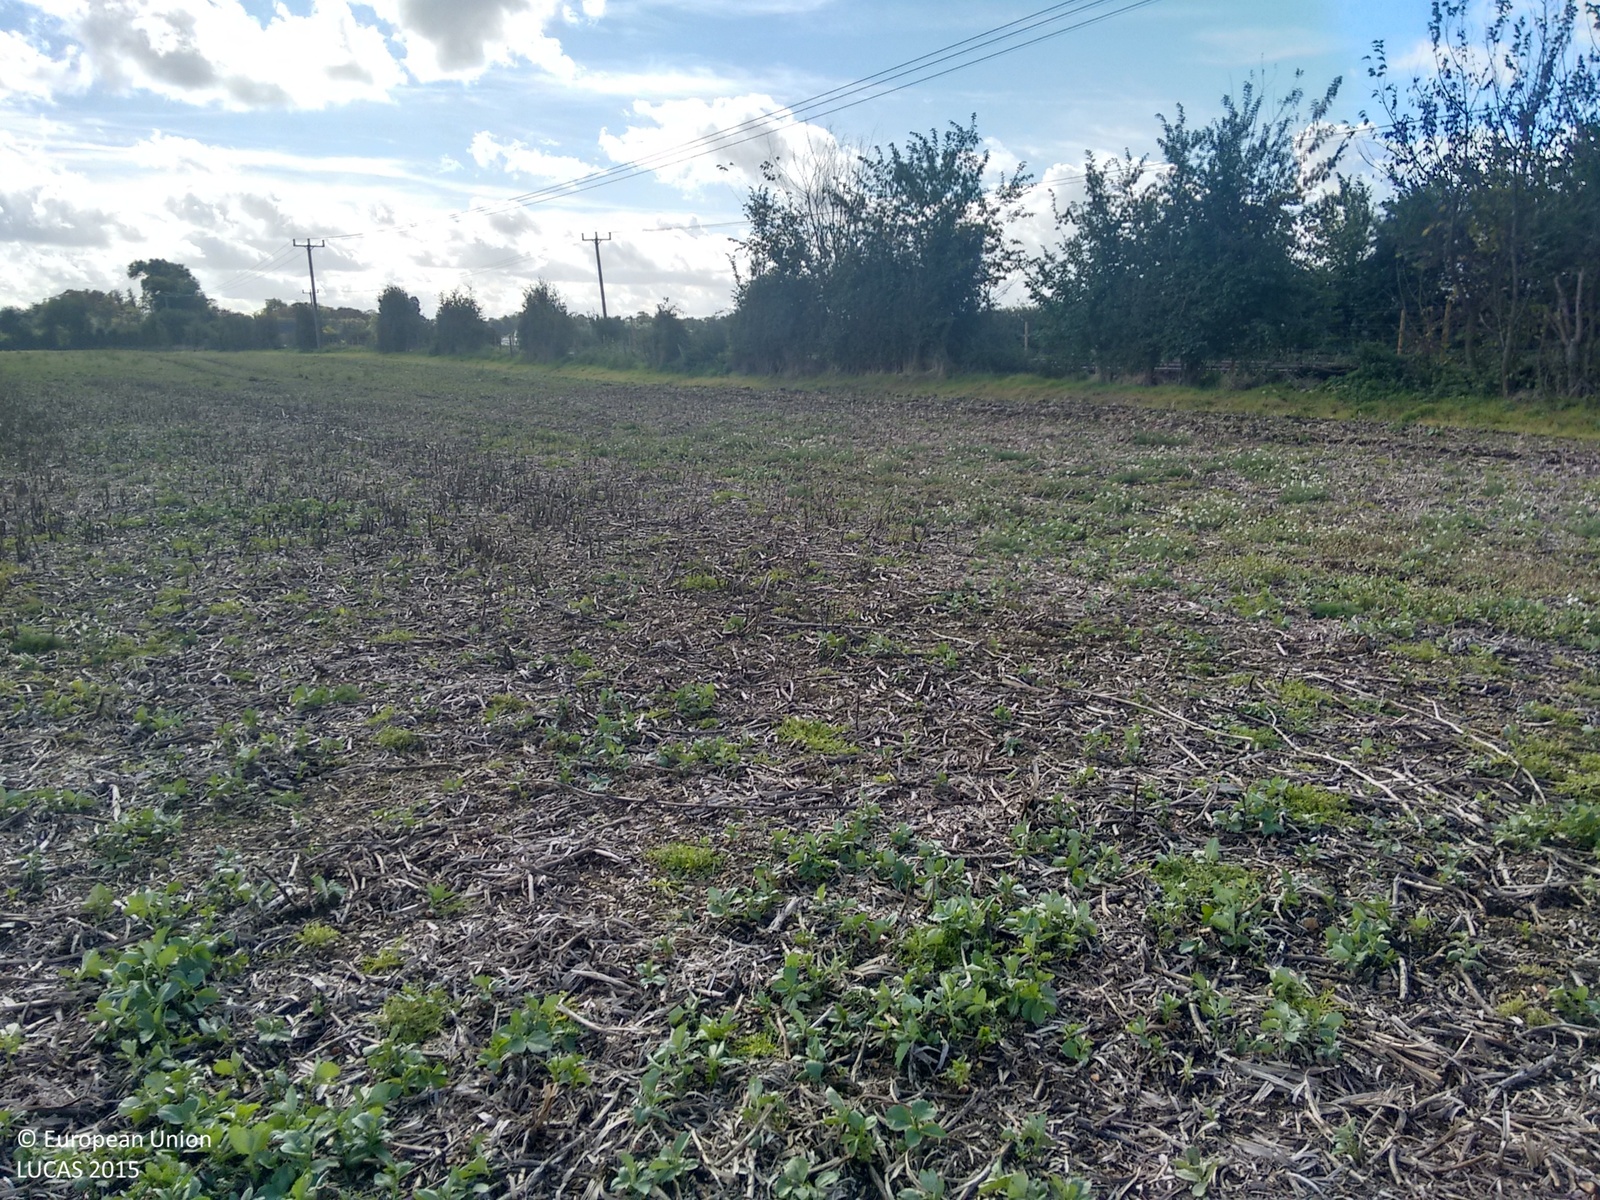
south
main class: Cropland
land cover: Dry pulses
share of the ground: 50 - 75 %
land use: Agriculture (excluding fallow land and kitchen gardens)
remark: Harvested field
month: September
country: GB
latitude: 52.1216
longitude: 0.0507
